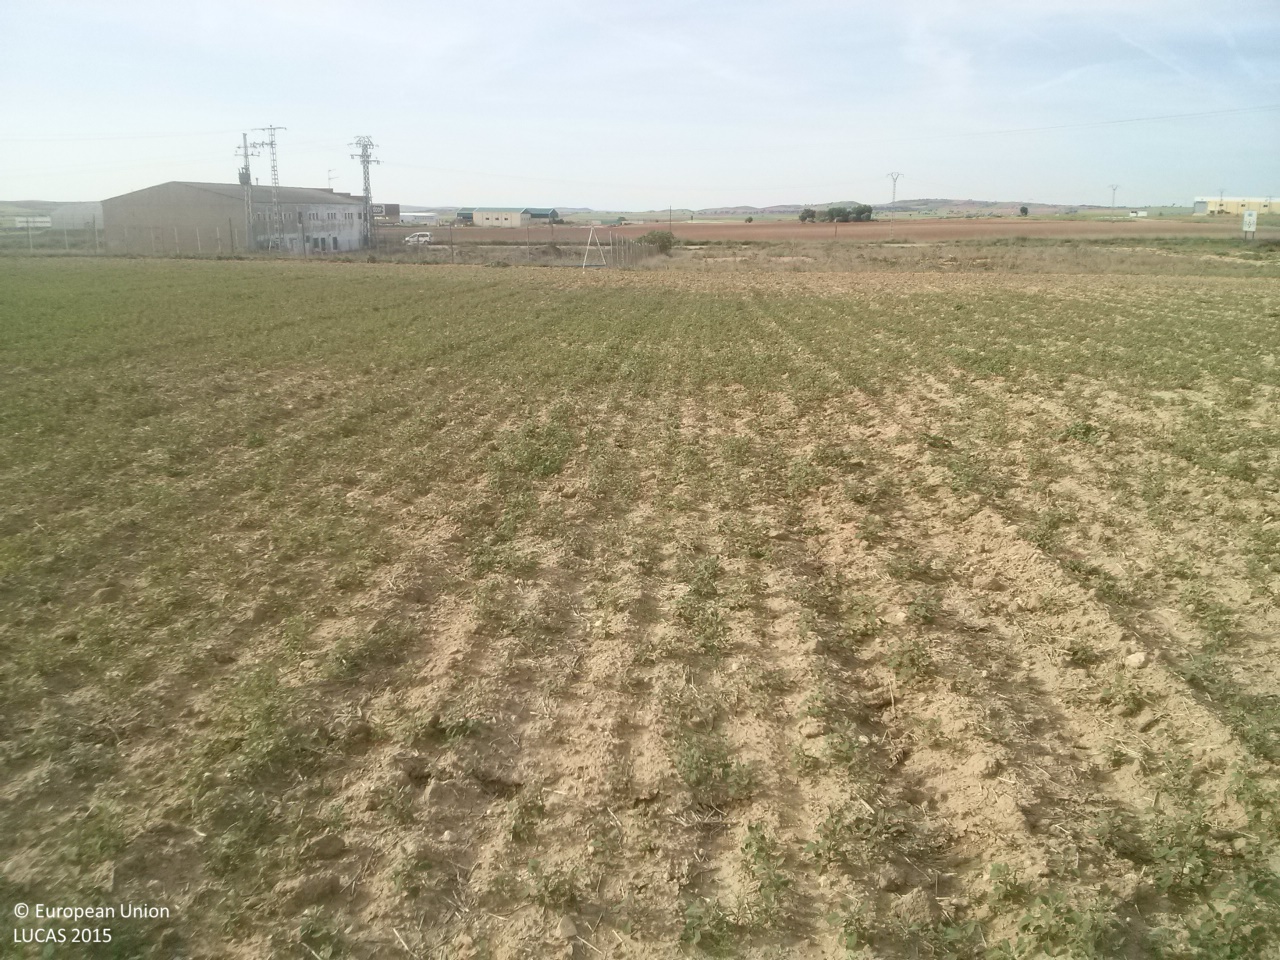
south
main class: Grassland
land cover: Spontaneously vegetated surfaces
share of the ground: 25 - 50 %
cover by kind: unconsolidated bare surface 75 %, herbaceous plants 25 %
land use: Fallow land
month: May
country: ES
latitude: 39.8827
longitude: -2.6590
